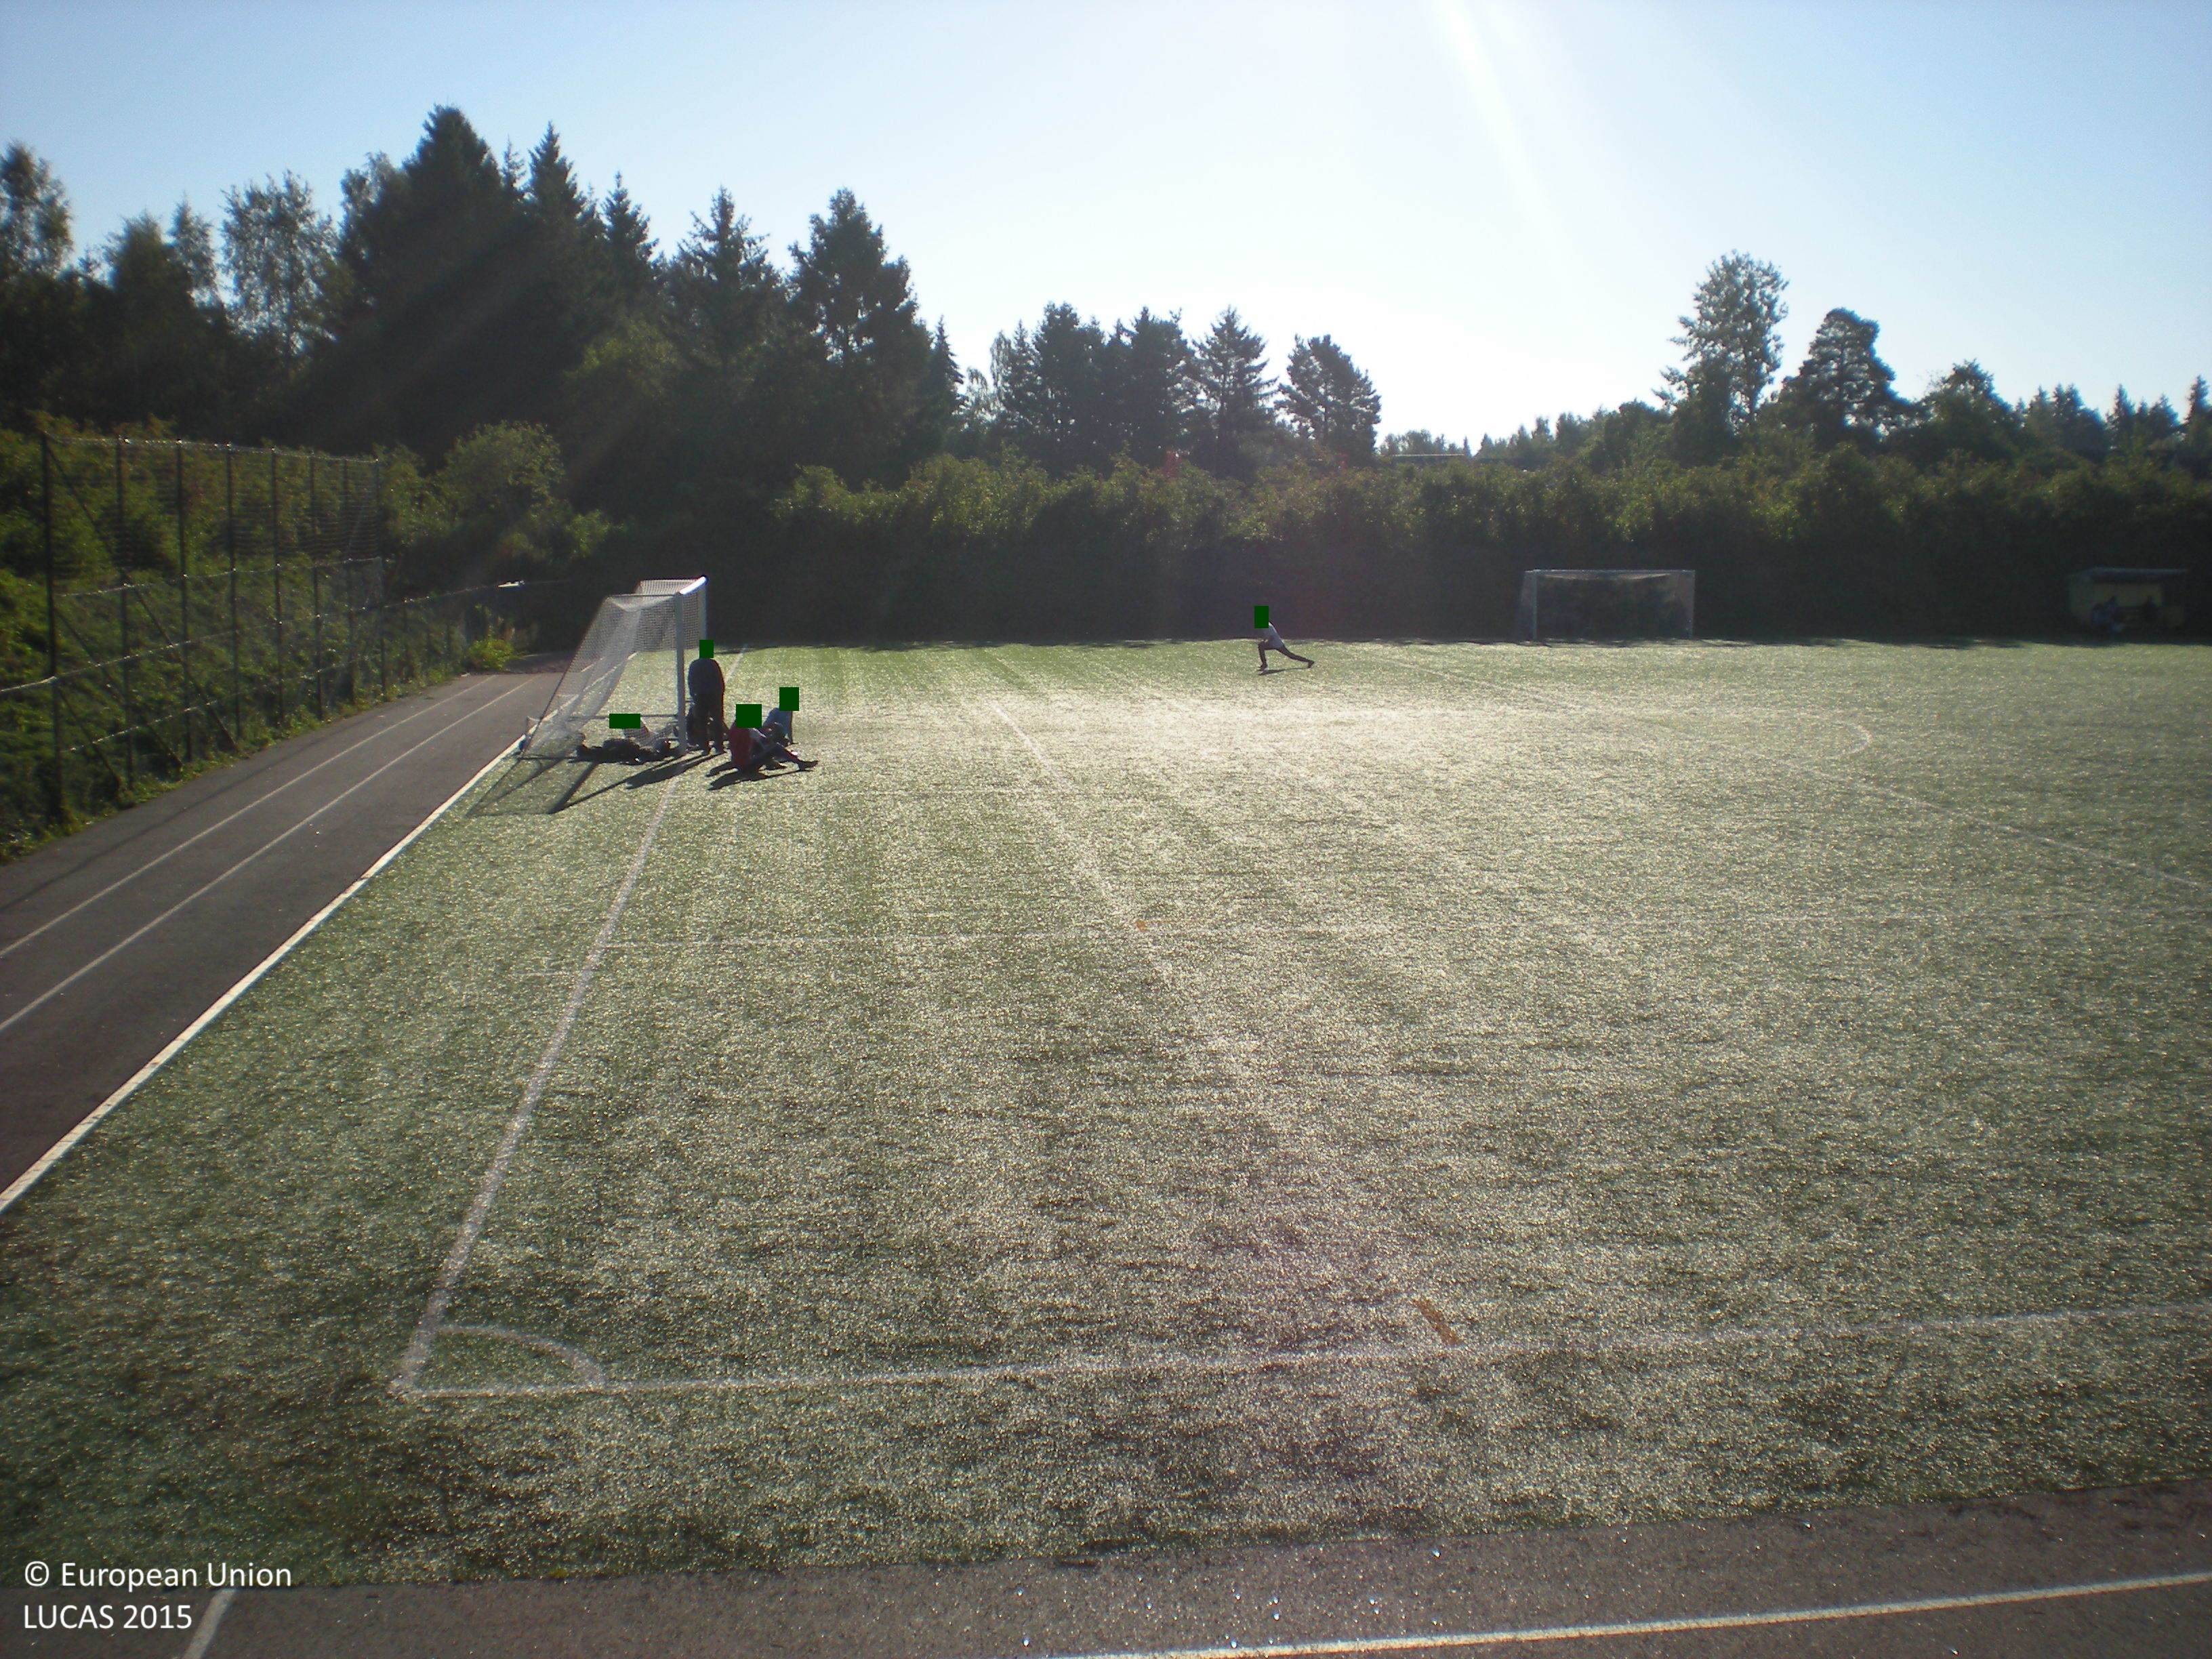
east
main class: Shrubland
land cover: Shrubland with sparse tree cover
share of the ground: > 75 %
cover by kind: shrubs 95 %, broadleaved forest trees 5 %
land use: Amenities, museums, leisure
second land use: Sport
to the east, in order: Shrubland with sparse tree cover; Artificial constructions in urban areas; Shrubland with sparse tree cover; Broadleaved woodland; Paved roads, cycling and walking lanes; Grassland without tree/shrub cover; Broadleaved woodland; Spruce dominated coniferous woodland; Broadleaved woodland; Paved roads, cycling and walking lanes; Lines of trees; Grassland without tree/shrub cover; Tracks; Broadleaved woodland; Artificial constructions in urban areas
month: August
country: SE
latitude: 60.6509
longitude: 17.1408
